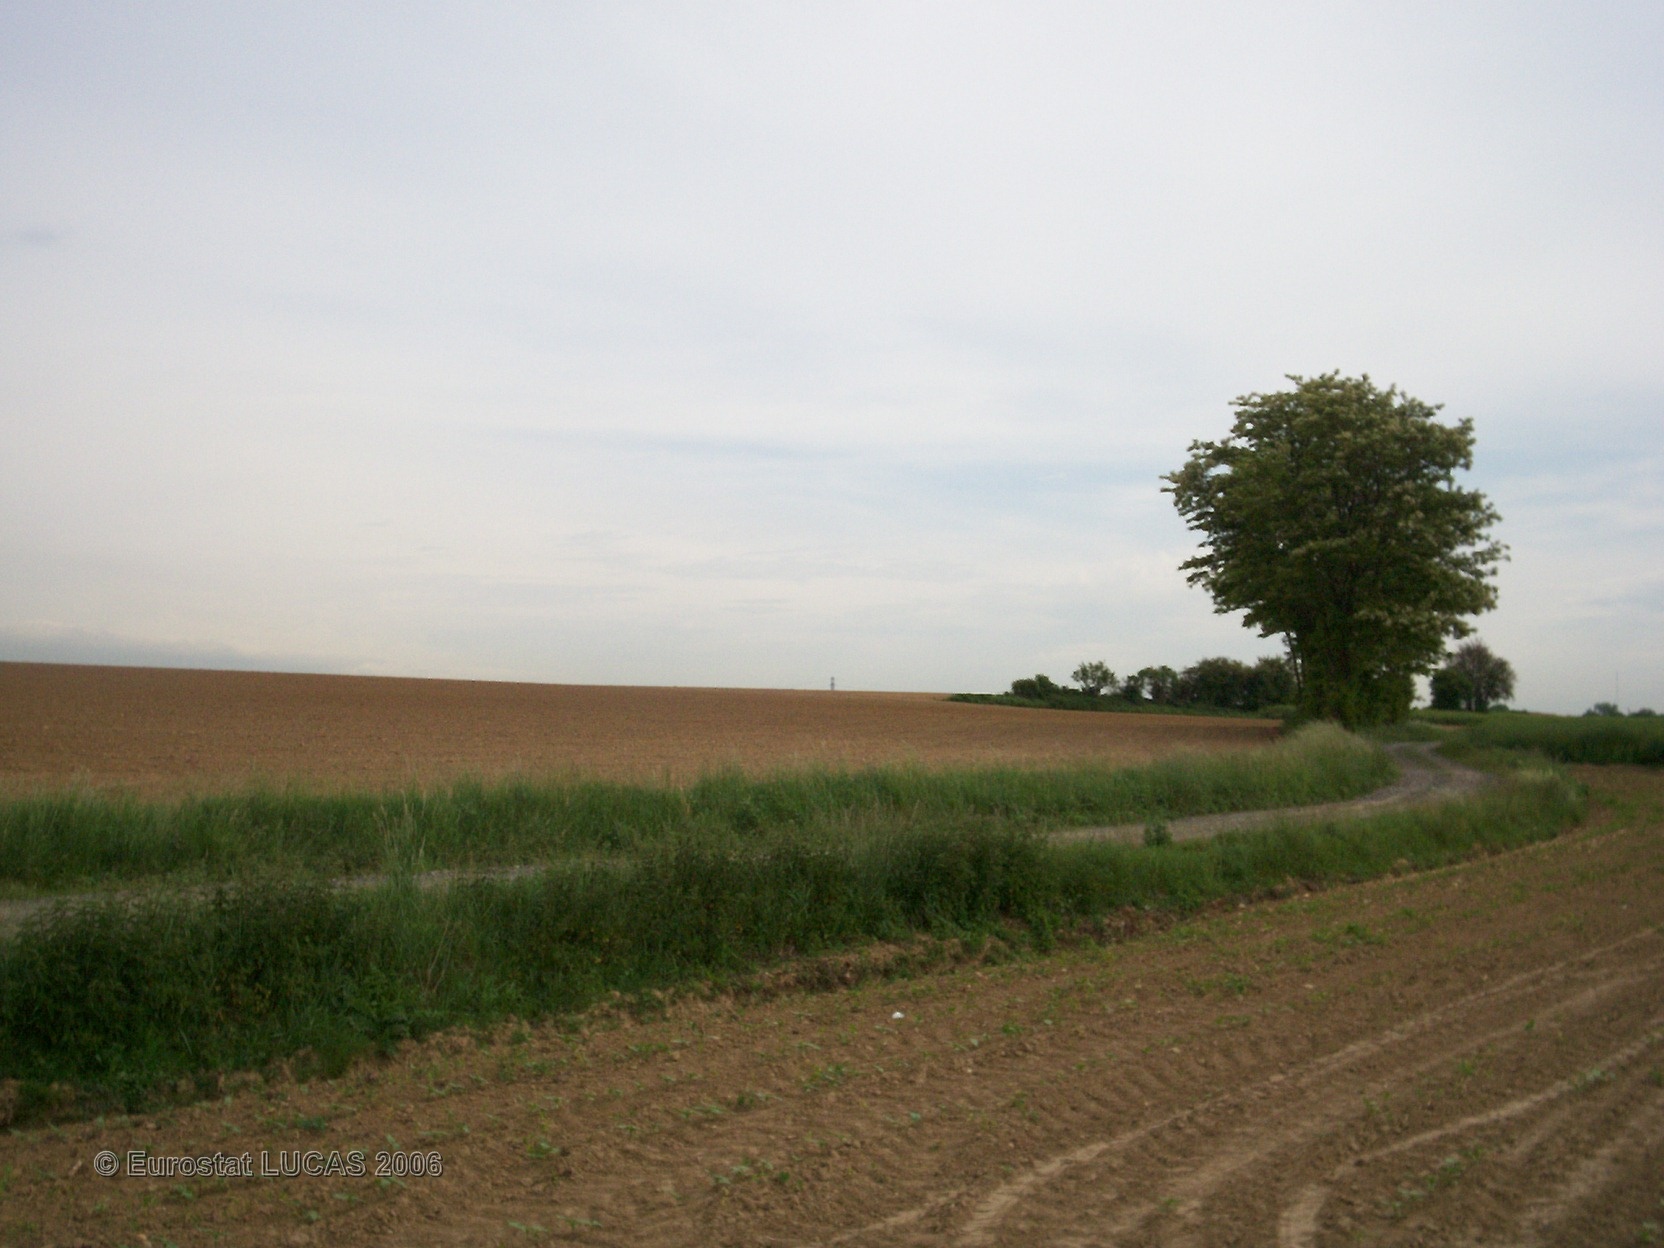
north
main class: Cropland
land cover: Soya
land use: Agriculture (excluding fallow land and kitchen gardens)
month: May
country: FR
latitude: 45.8501
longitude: 4.8910
